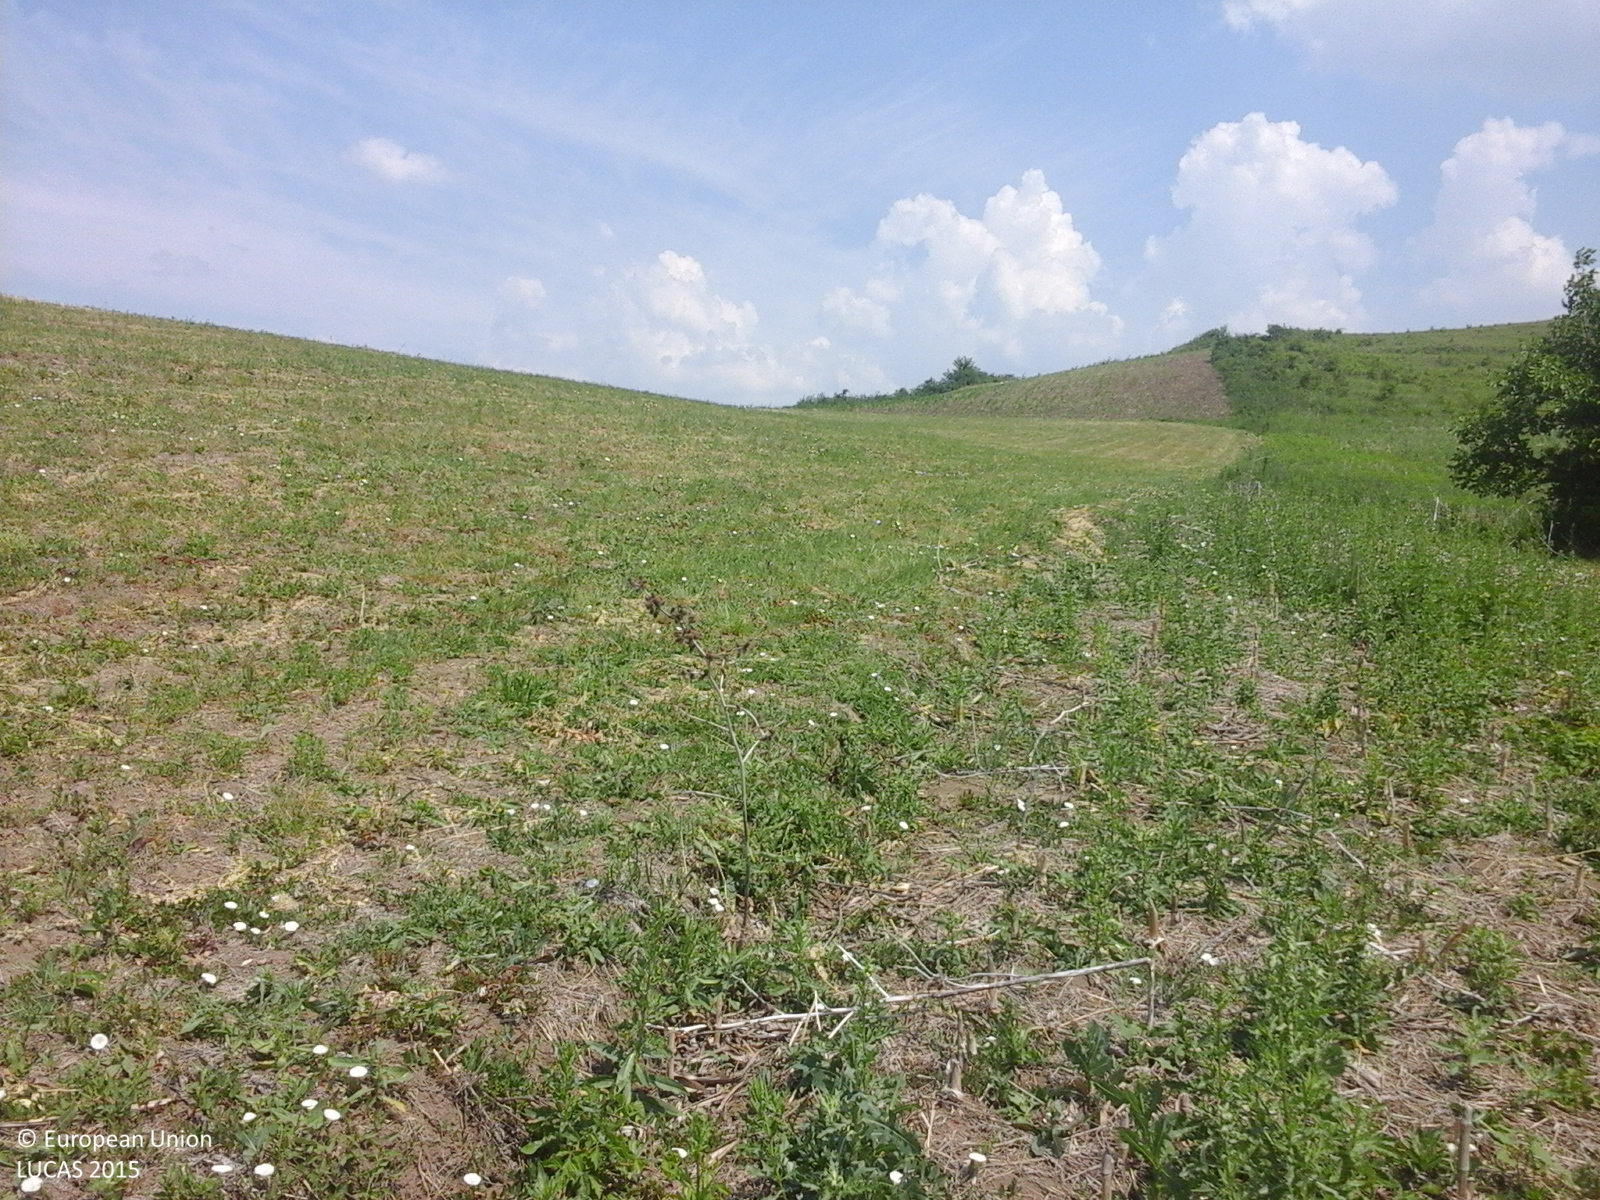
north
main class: Grassland
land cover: Spontaneously vegetated surfaces
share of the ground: > 75 %
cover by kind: herbaceous plants 100 %
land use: Agriculture (excluding fallow land and kitchen gardens)
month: June
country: RO
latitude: 46.3923
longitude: 27.1217
